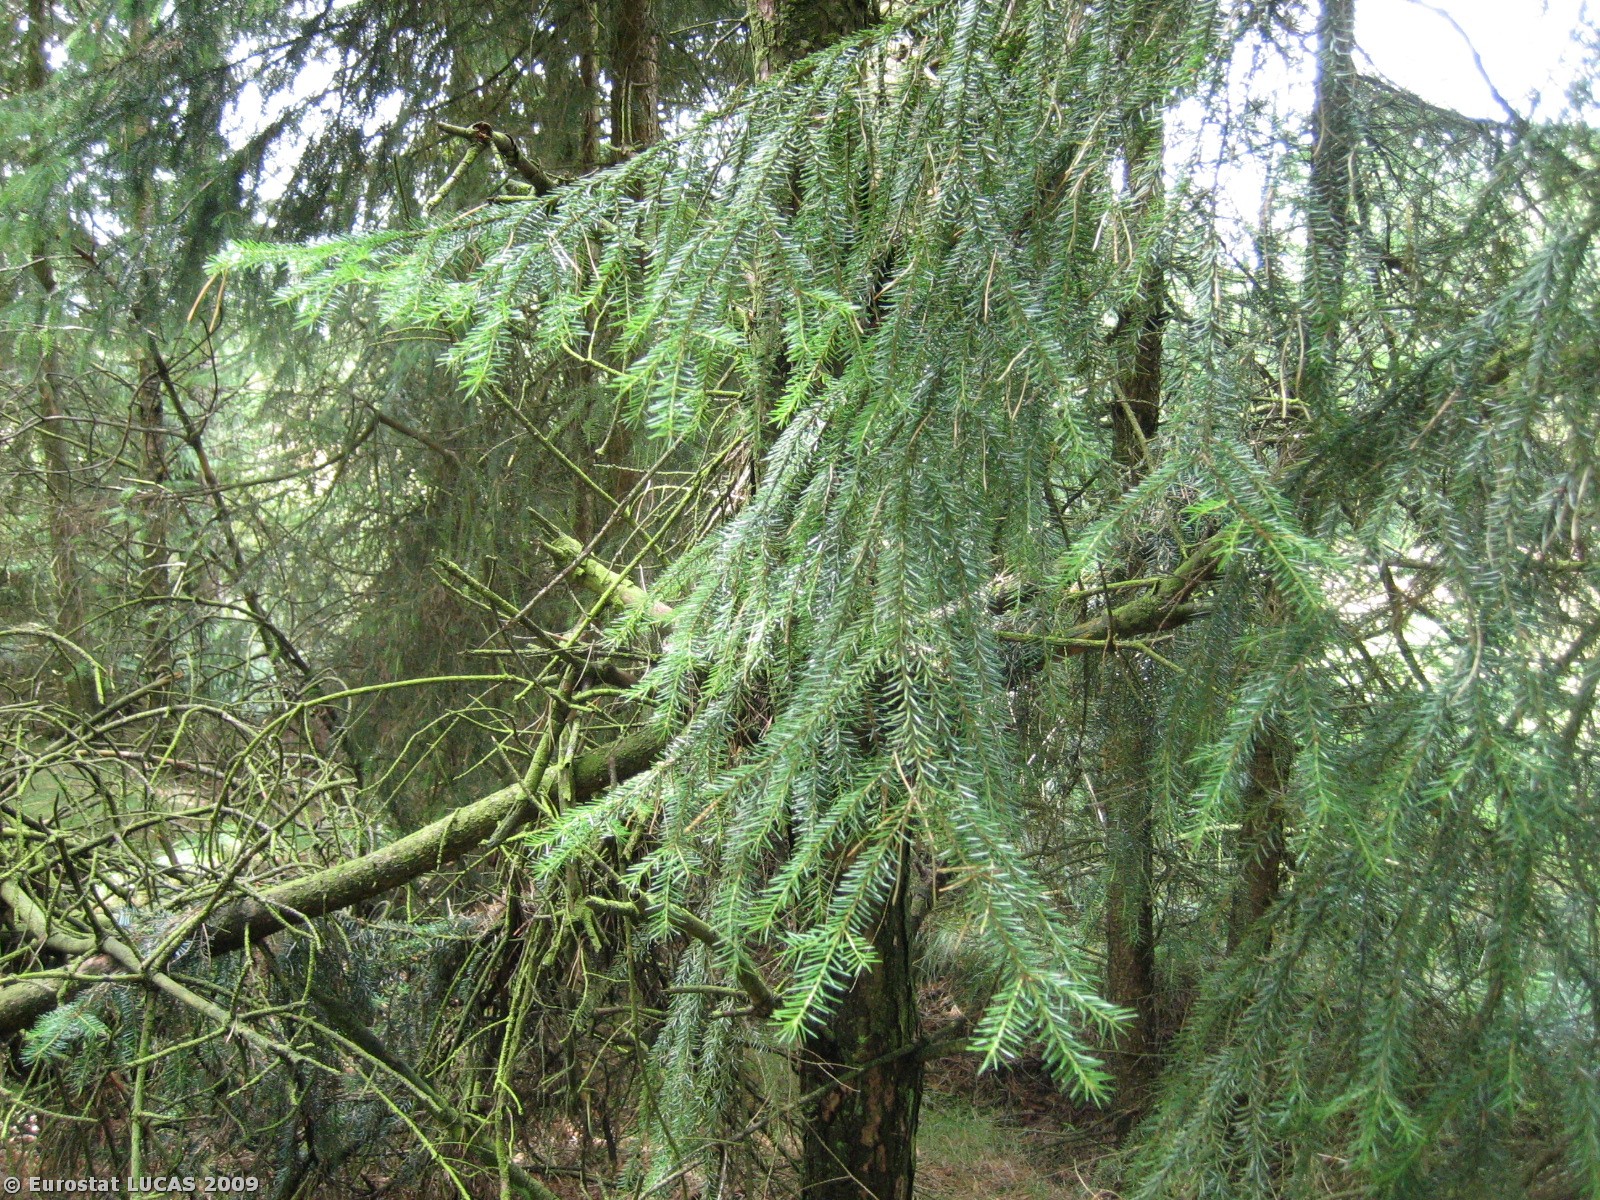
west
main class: Woodland
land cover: Coniferous woodland
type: hemiboreal forest and nemoral coniferous forest and mixed broadleaved-coniferous forest
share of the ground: > 75 %
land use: Forestry
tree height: > 5 m
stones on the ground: < 10 %
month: July
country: DK
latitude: 55.6786
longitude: 8.7767
